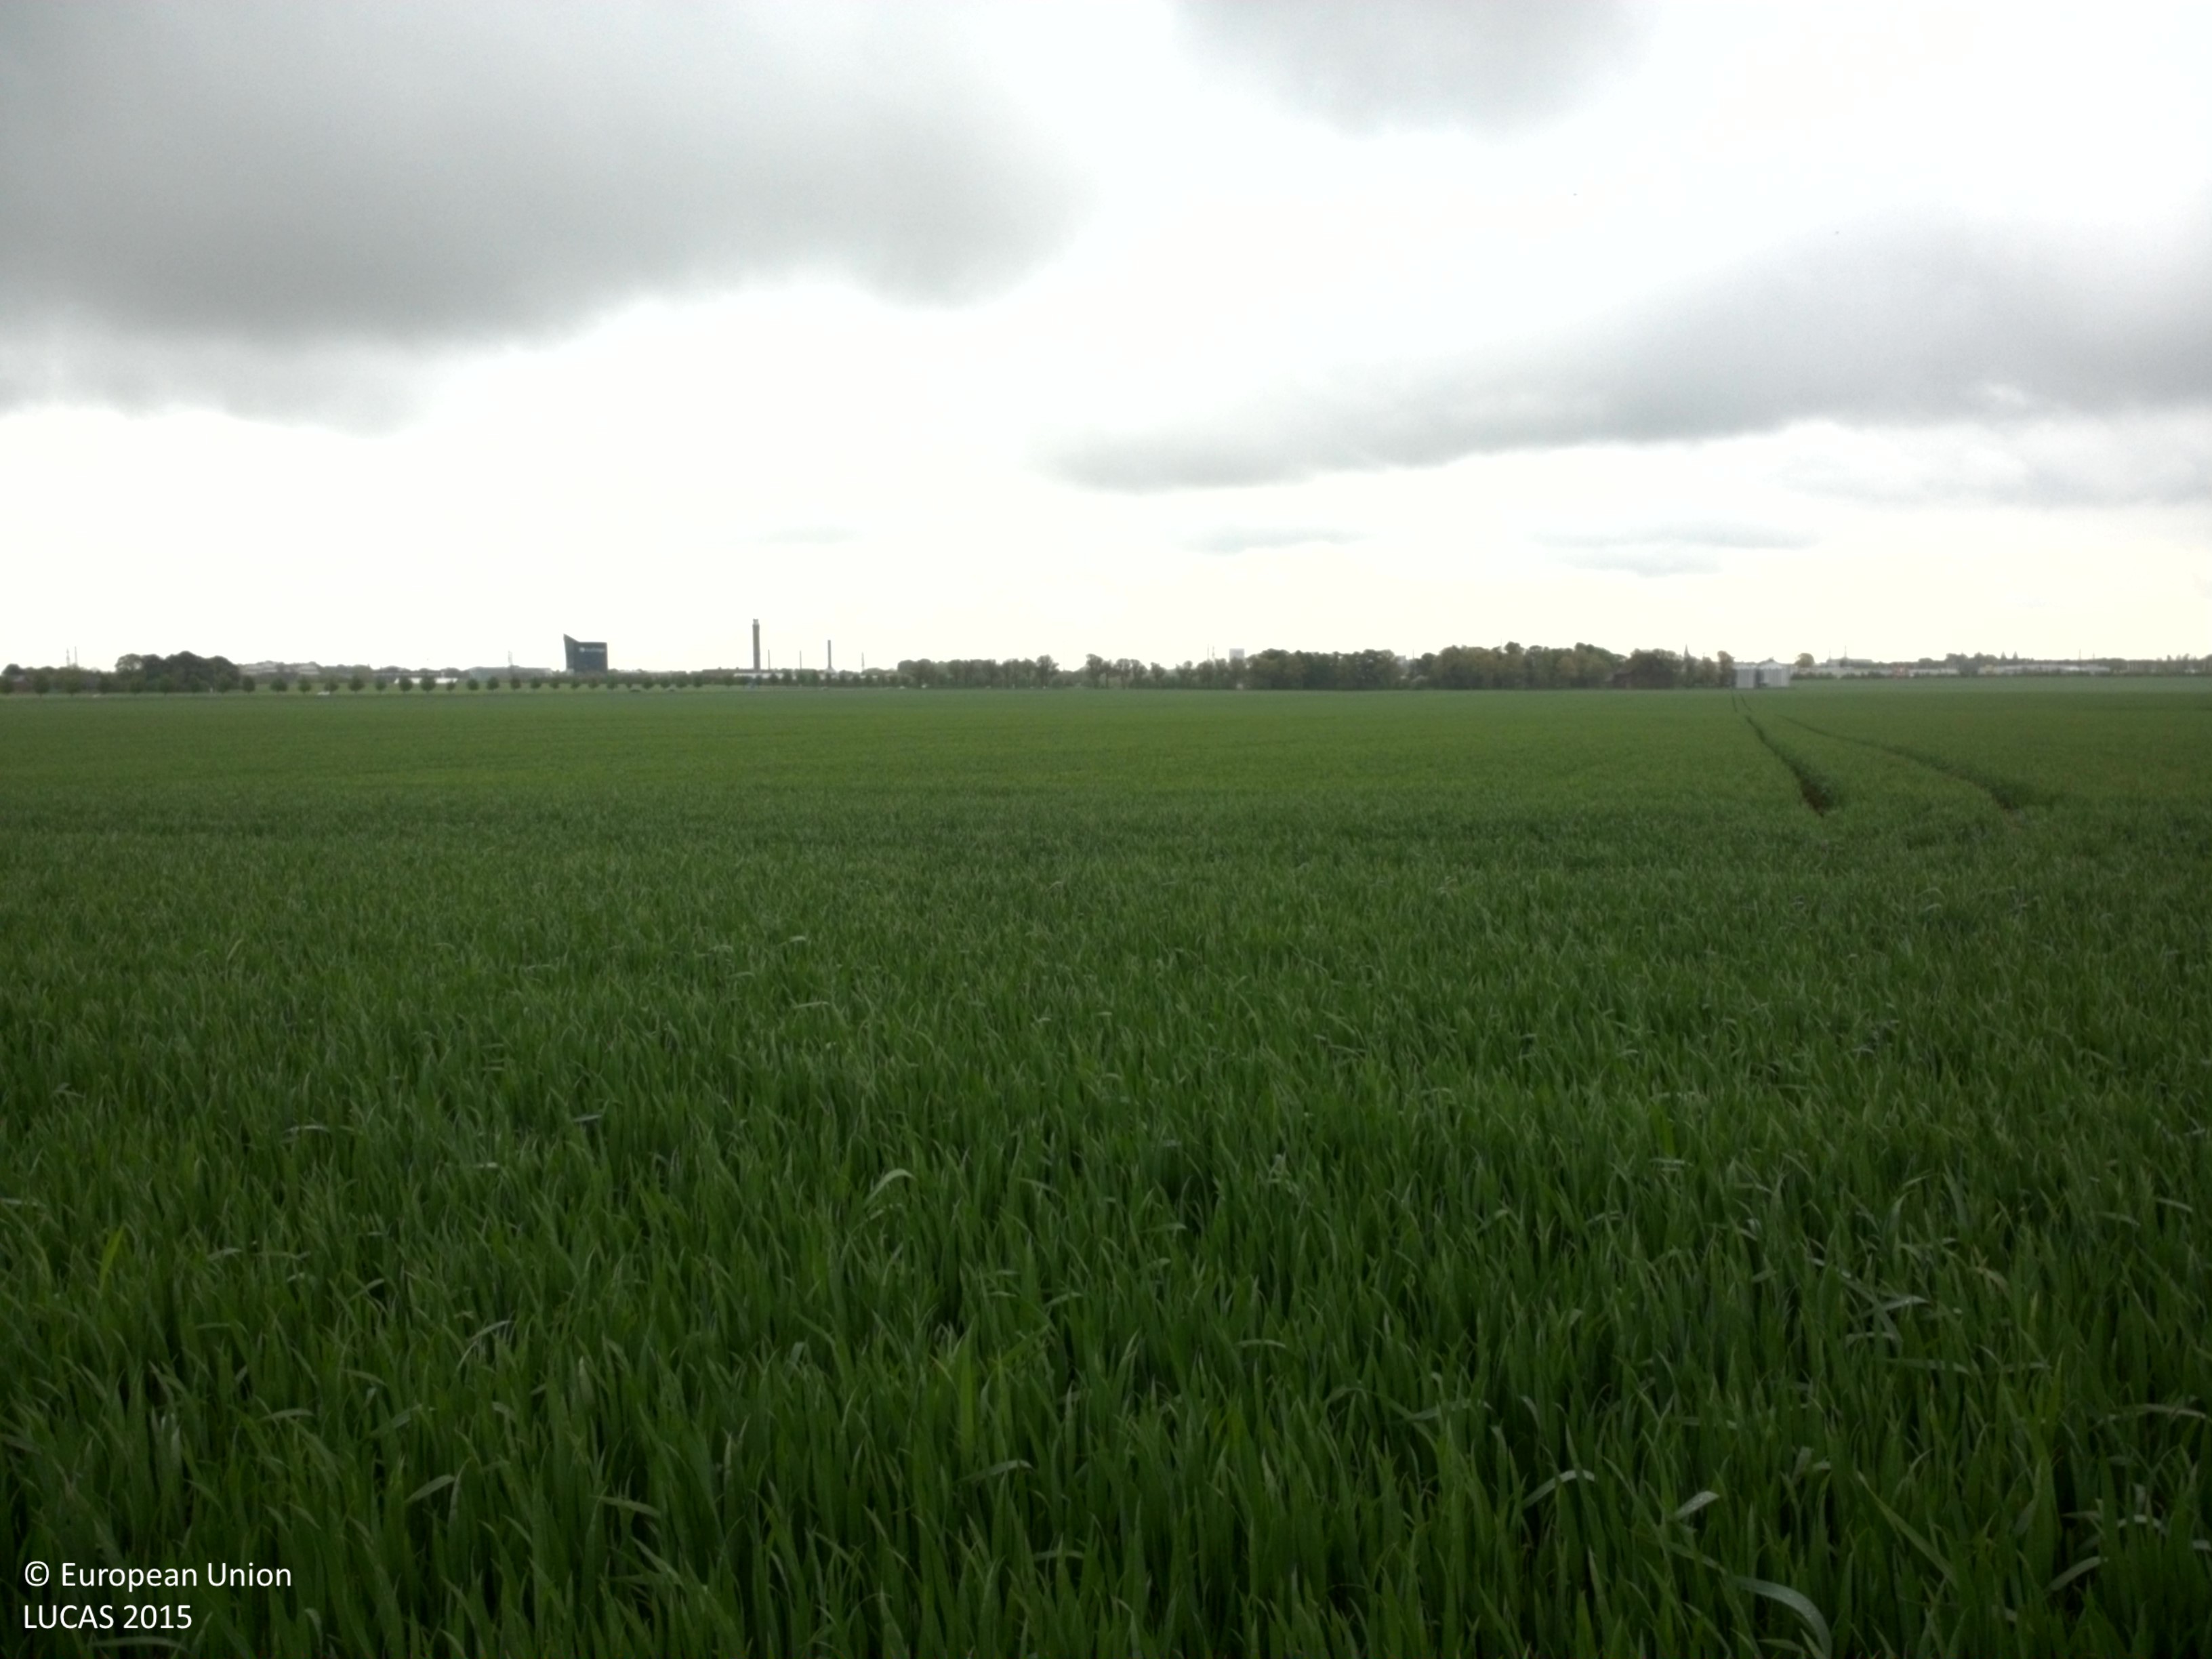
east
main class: Cropland
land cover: Common wheat
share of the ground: > 75 %
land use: Agriculture (excluding fallow land and kitchen gardens)
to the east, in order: Common wheat
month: May
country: SE
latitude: 55.7178
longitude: 13.1339
